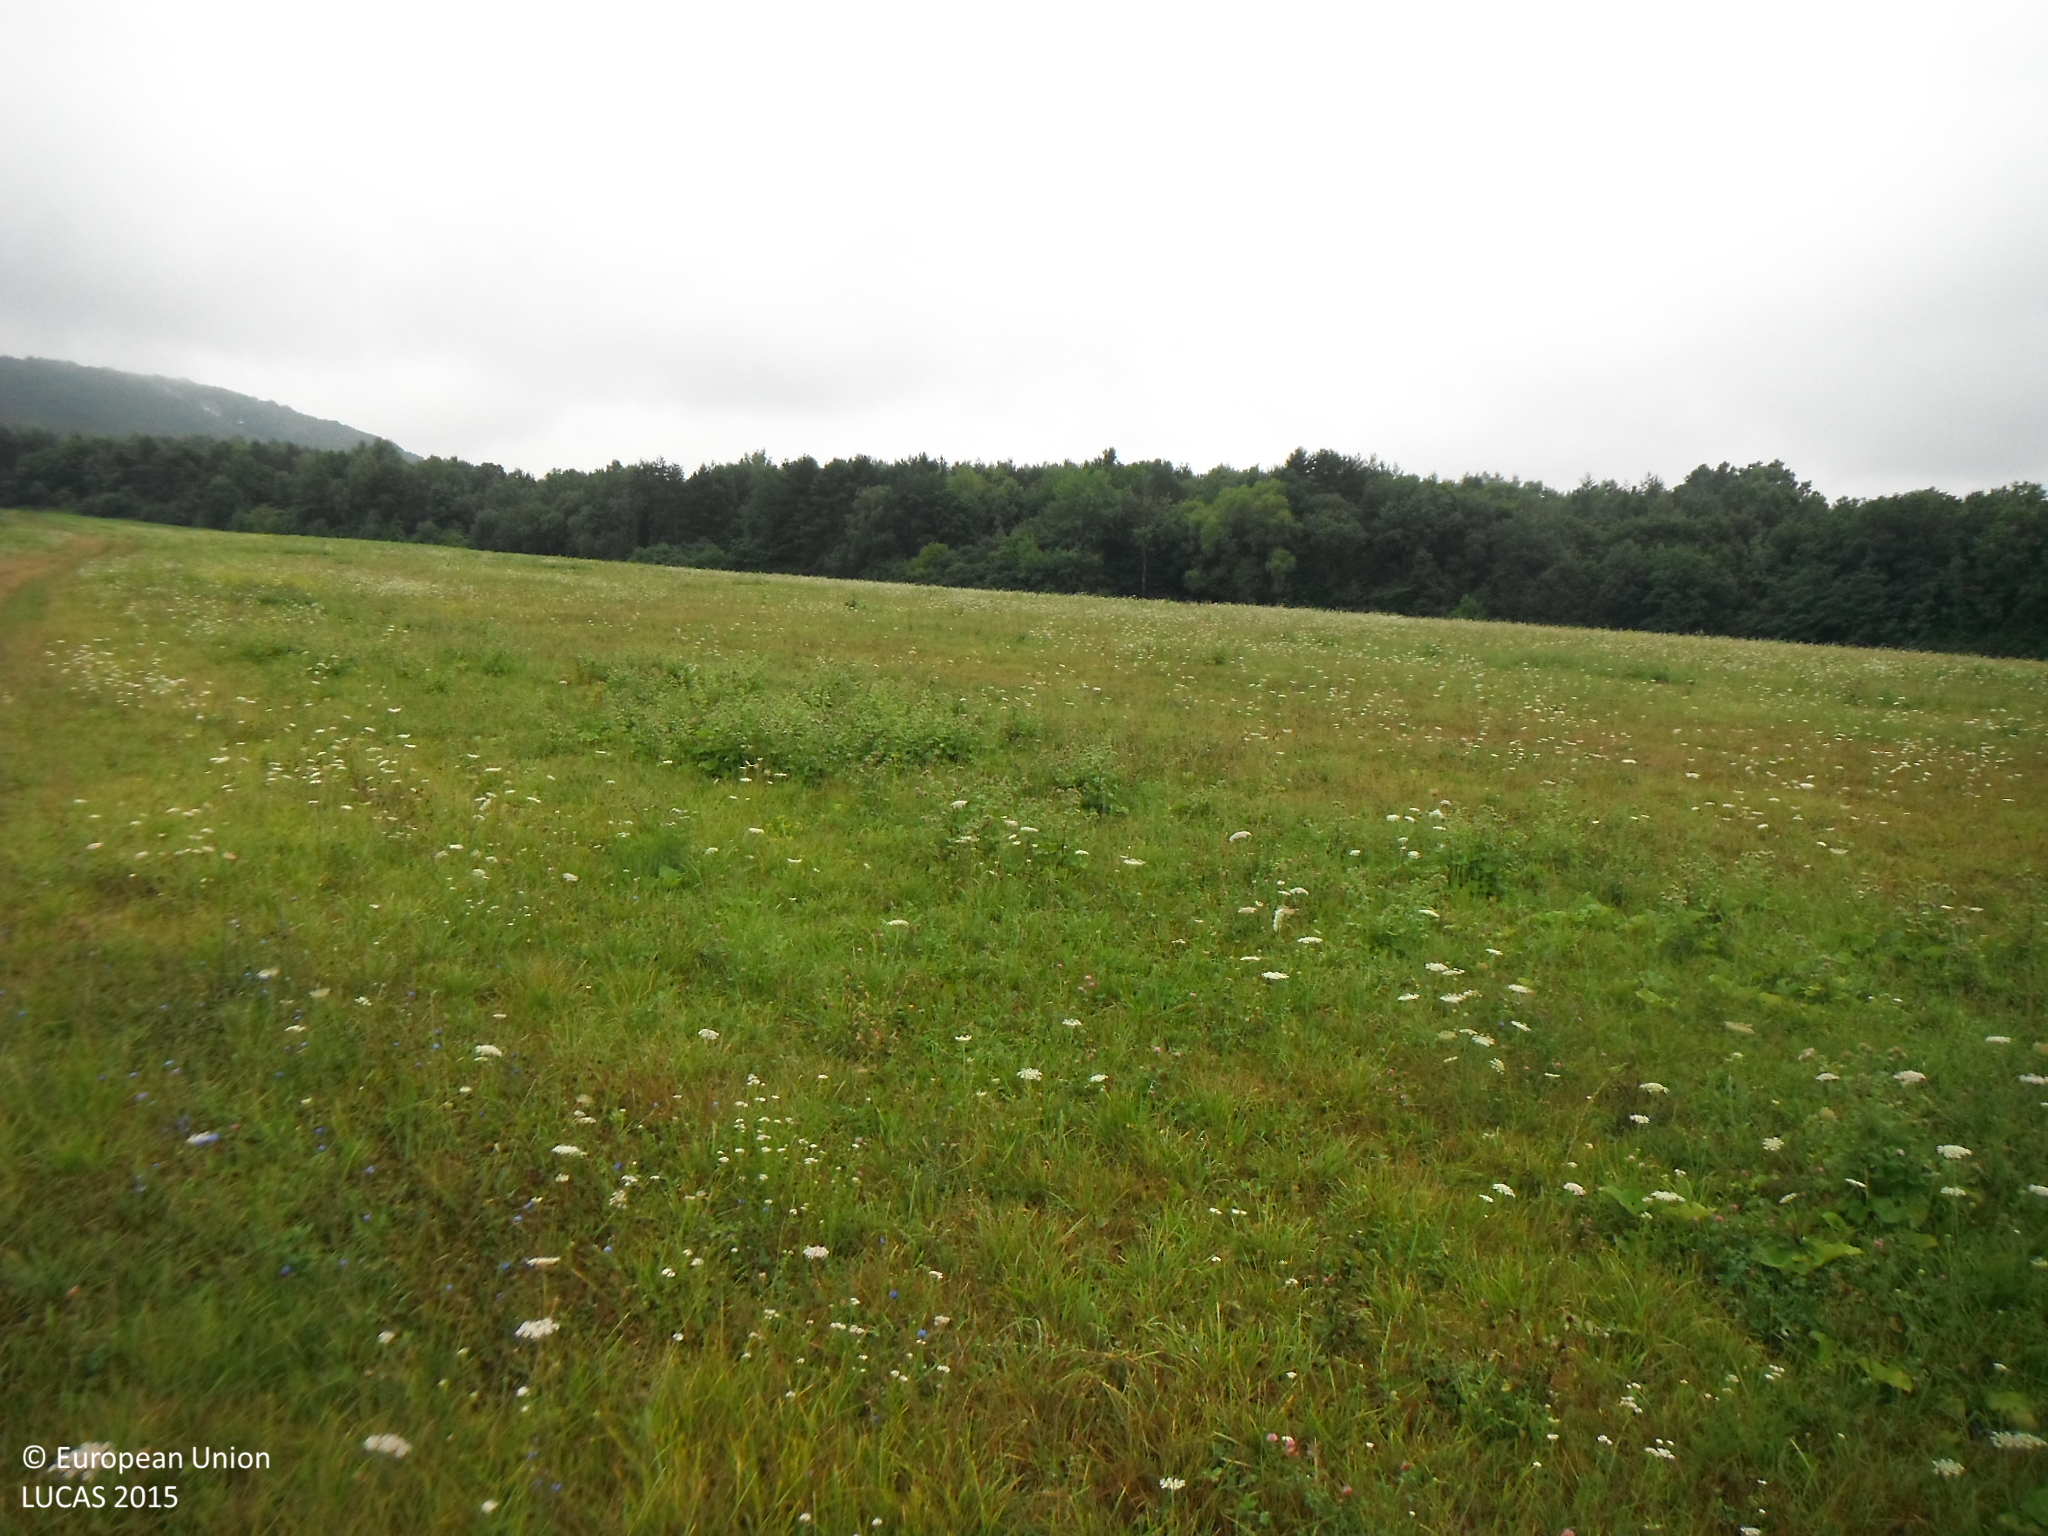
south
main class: Grassland
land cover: Grassland without tree/shrub cover
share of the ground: > 75 %
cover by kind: herbaceous plants 100 %
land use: Agriculture (excluding fallow land and kitchen gardens)
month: July
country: SK
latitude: 48.8971
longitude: 21.9630
